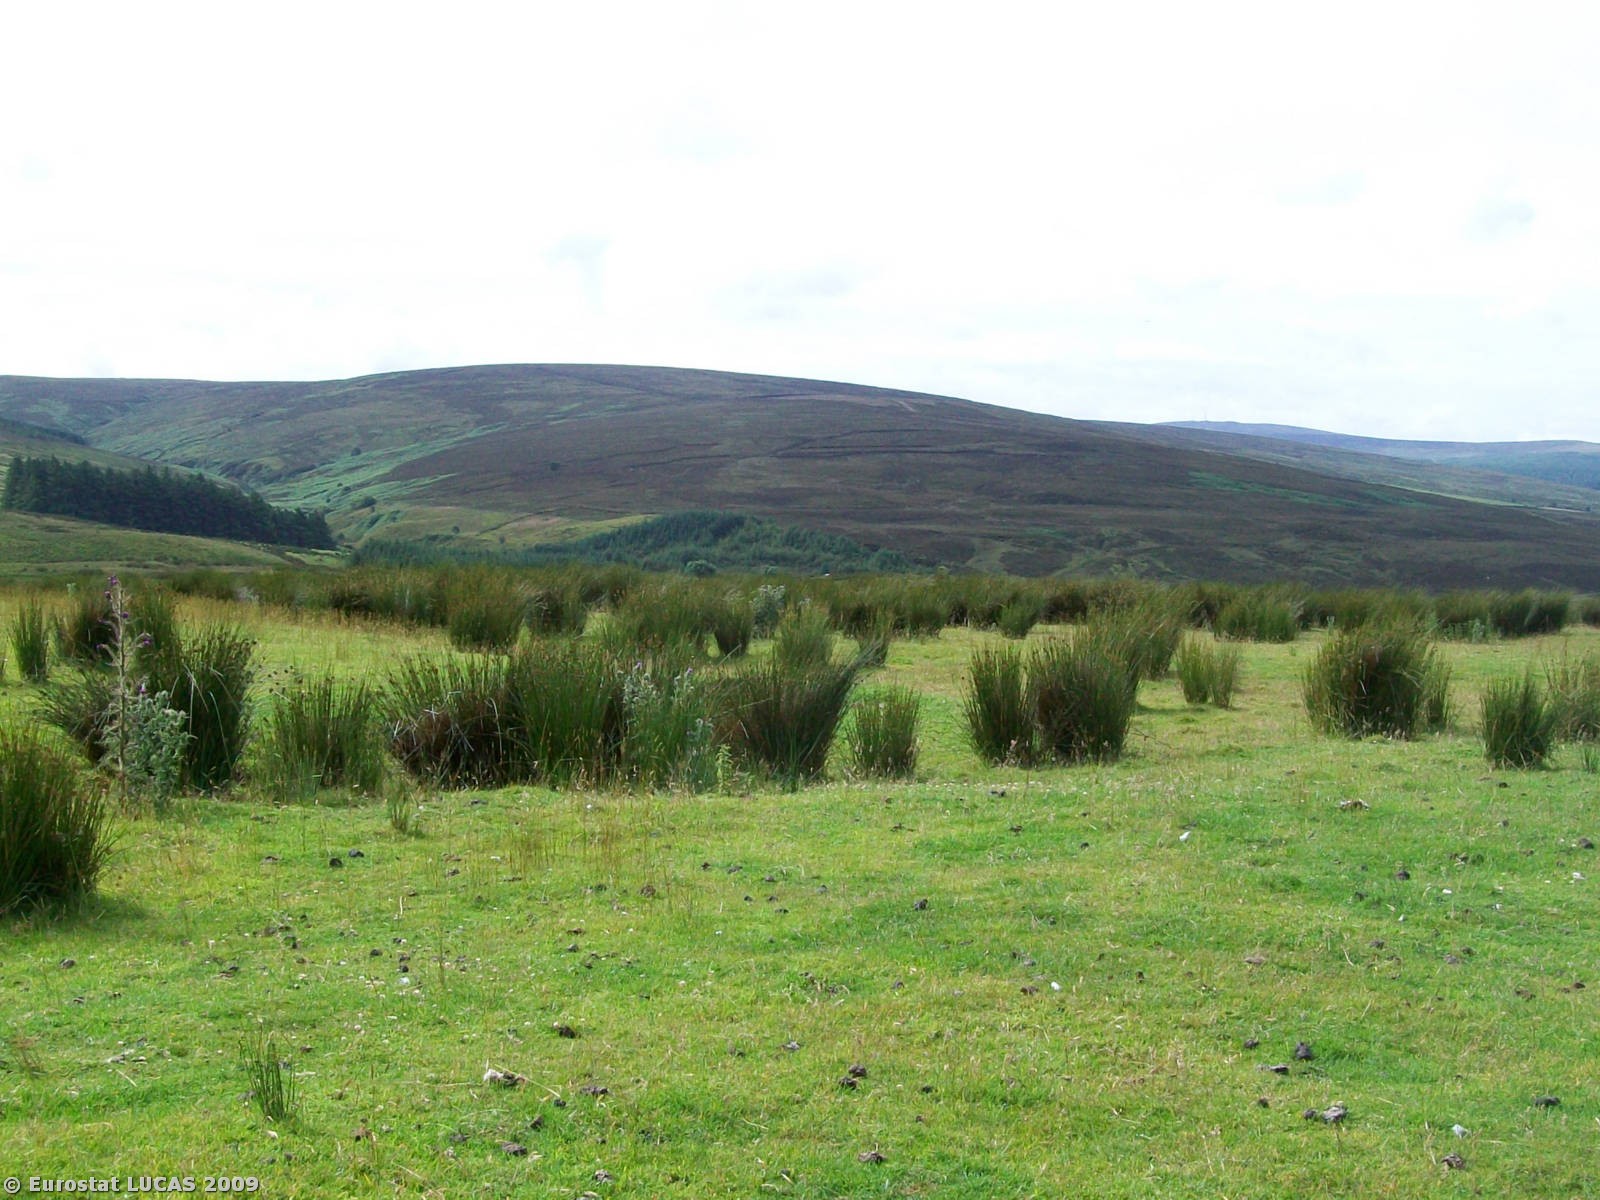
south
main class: Grassland
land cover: Grassland without tree/shrub cover
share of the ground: > 75 %
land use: Agriculture (excluding fallow land and kitchen gardens)
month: July
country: GB
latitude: 55.1484
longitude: -6.1965
